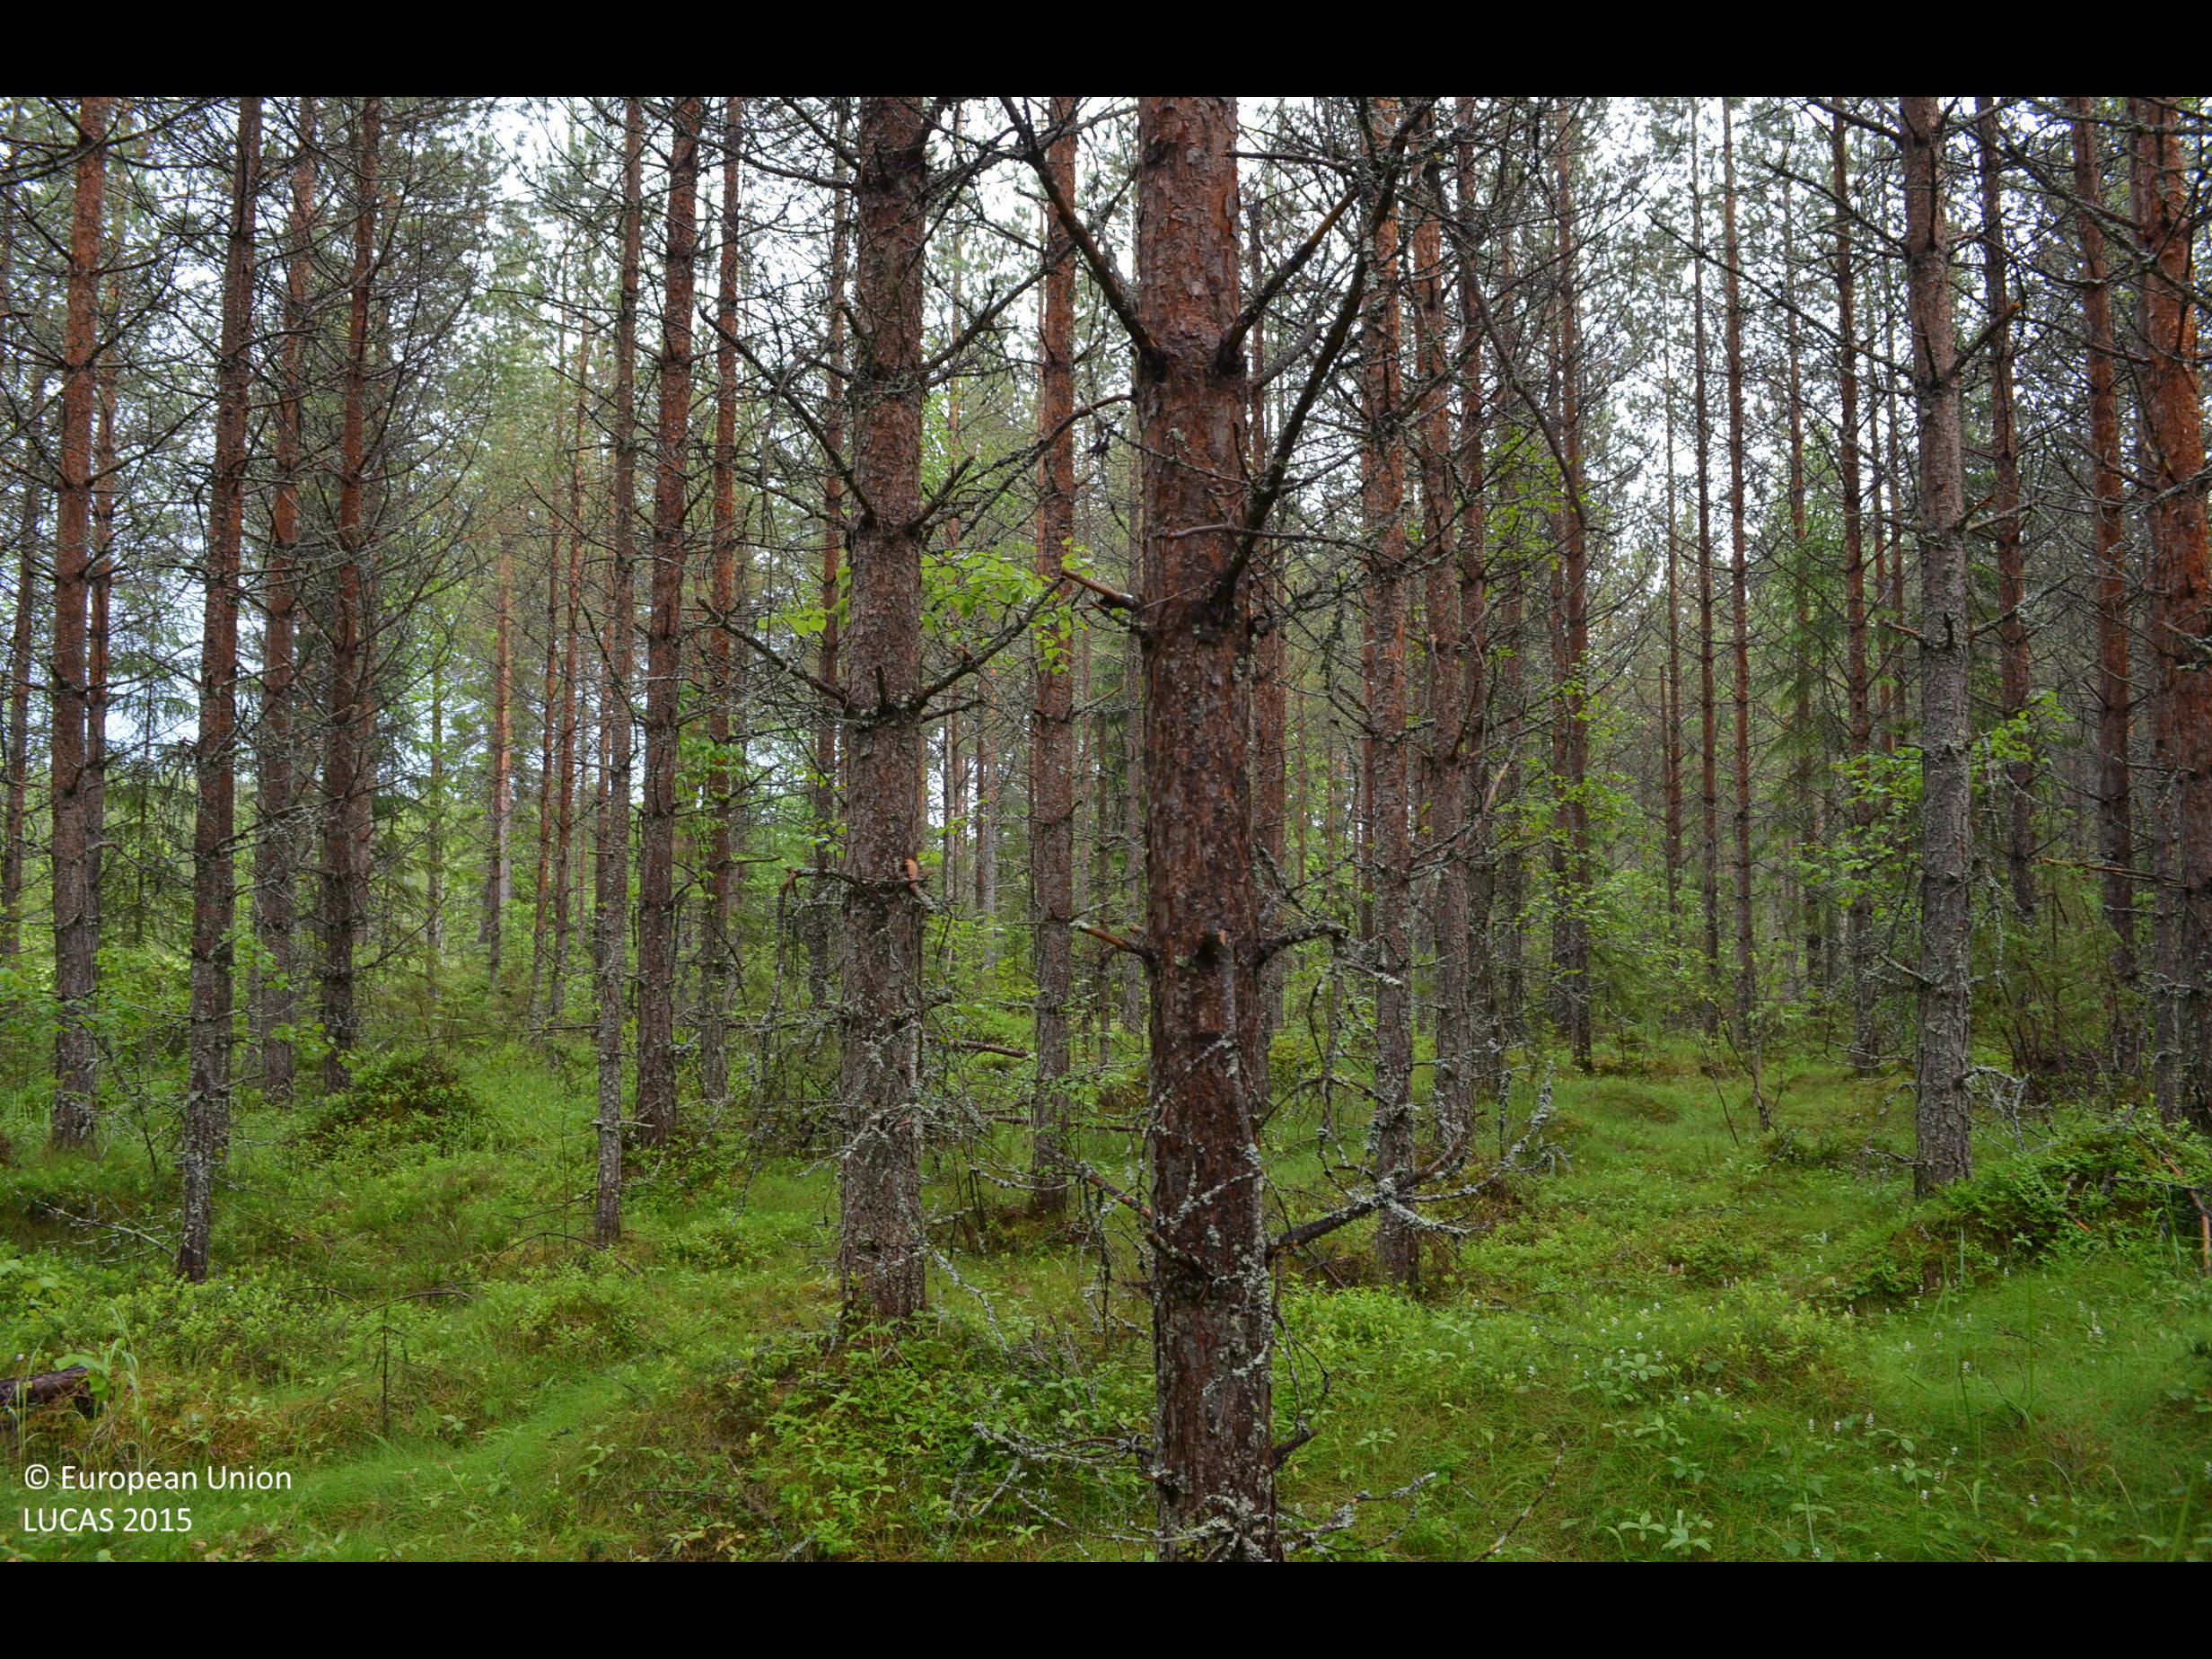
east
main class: Woodland
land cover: Pine dominated coniferous woodland
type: boreal forest
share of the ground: > 75 %
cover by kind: coniferous forest trees 80 %, broadleaved forest trees 10 %, shrubs 5 %, herbaceous plants 5 %
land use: Forestry
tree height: > 5 m
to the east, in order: Pine dominated coniferous woodland; Shrubland without tree cover; Ditches and canals; Shrubland without tree cover; Pine dominated mixed woodland; Ditches and canals; Shruby margins; Tracks; Grass margins; Other mixed woodland
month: June
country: FI
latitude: 61.9974
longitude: 23.5360
